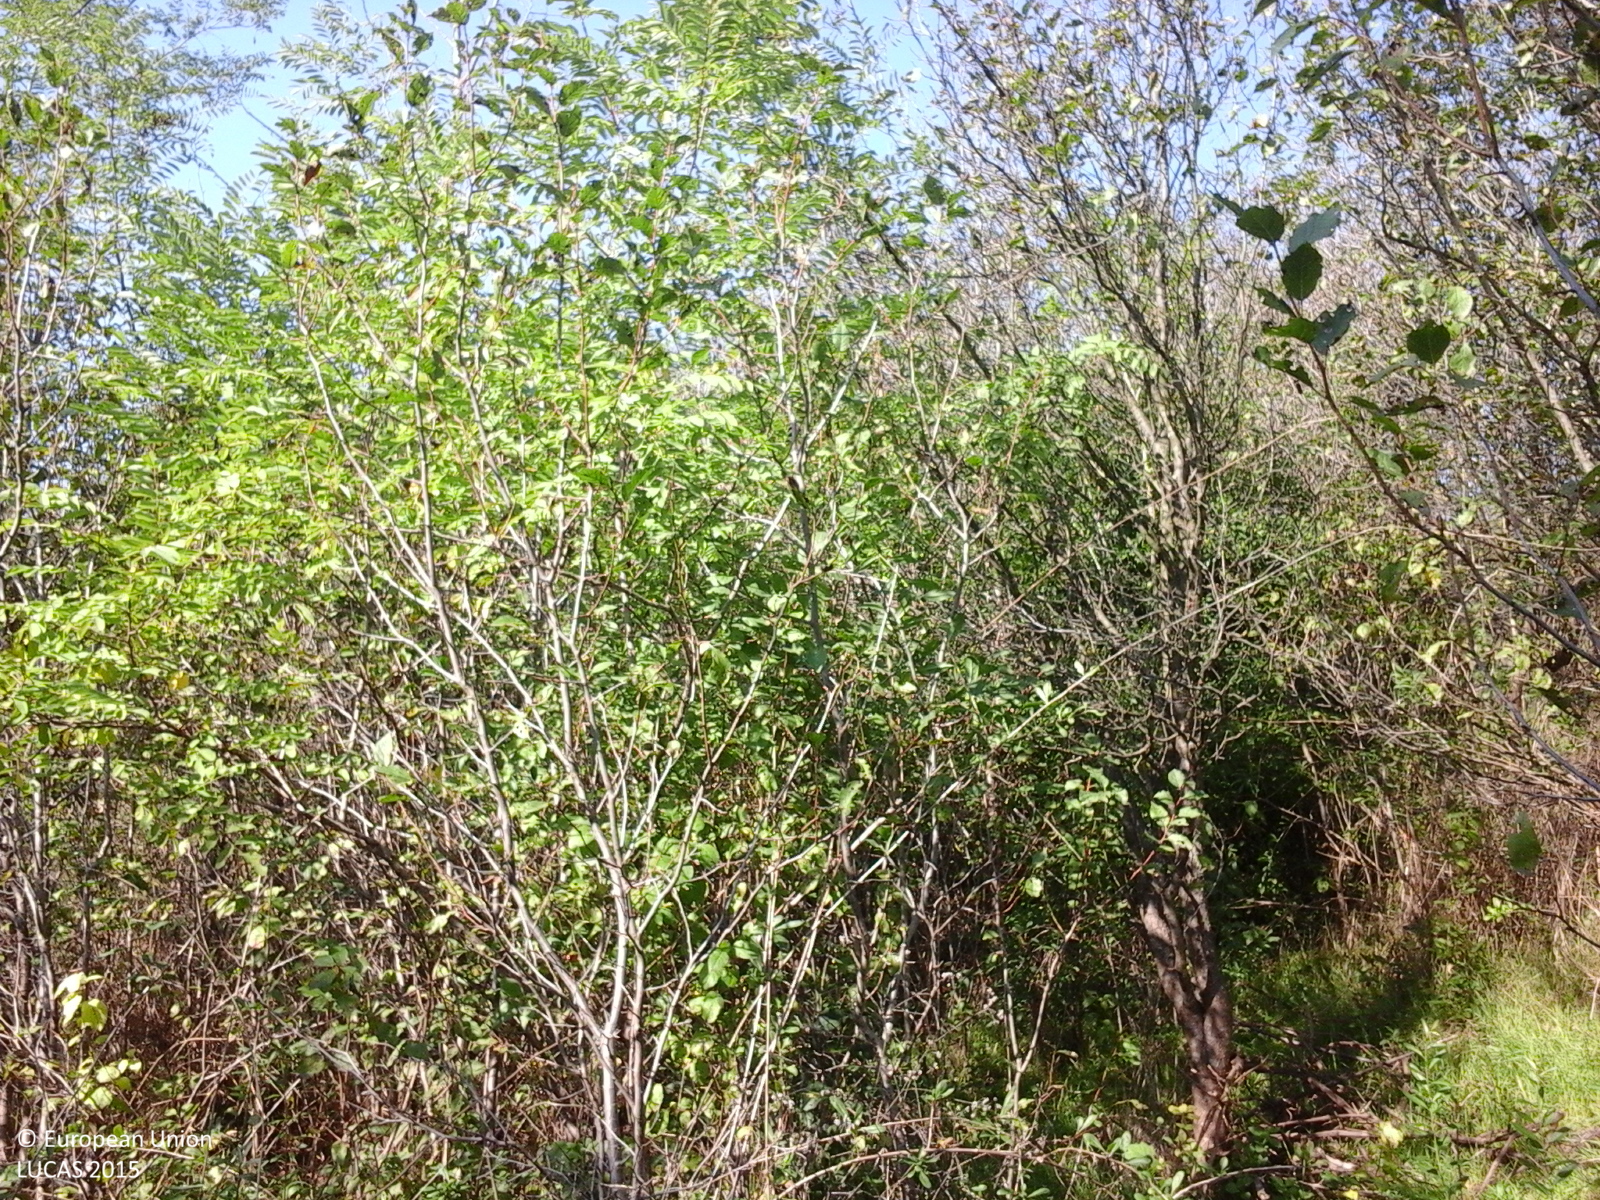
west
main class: Cropland
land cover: Other fruit trees and berries
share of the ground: 25 - 50 %
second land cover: Grassland without tree/shrub cover
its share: > 75 %
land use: Agriculture (excluding fallow land and kitchen gardens)
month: October
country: RO
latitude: 46.0740
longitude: 23.7885
